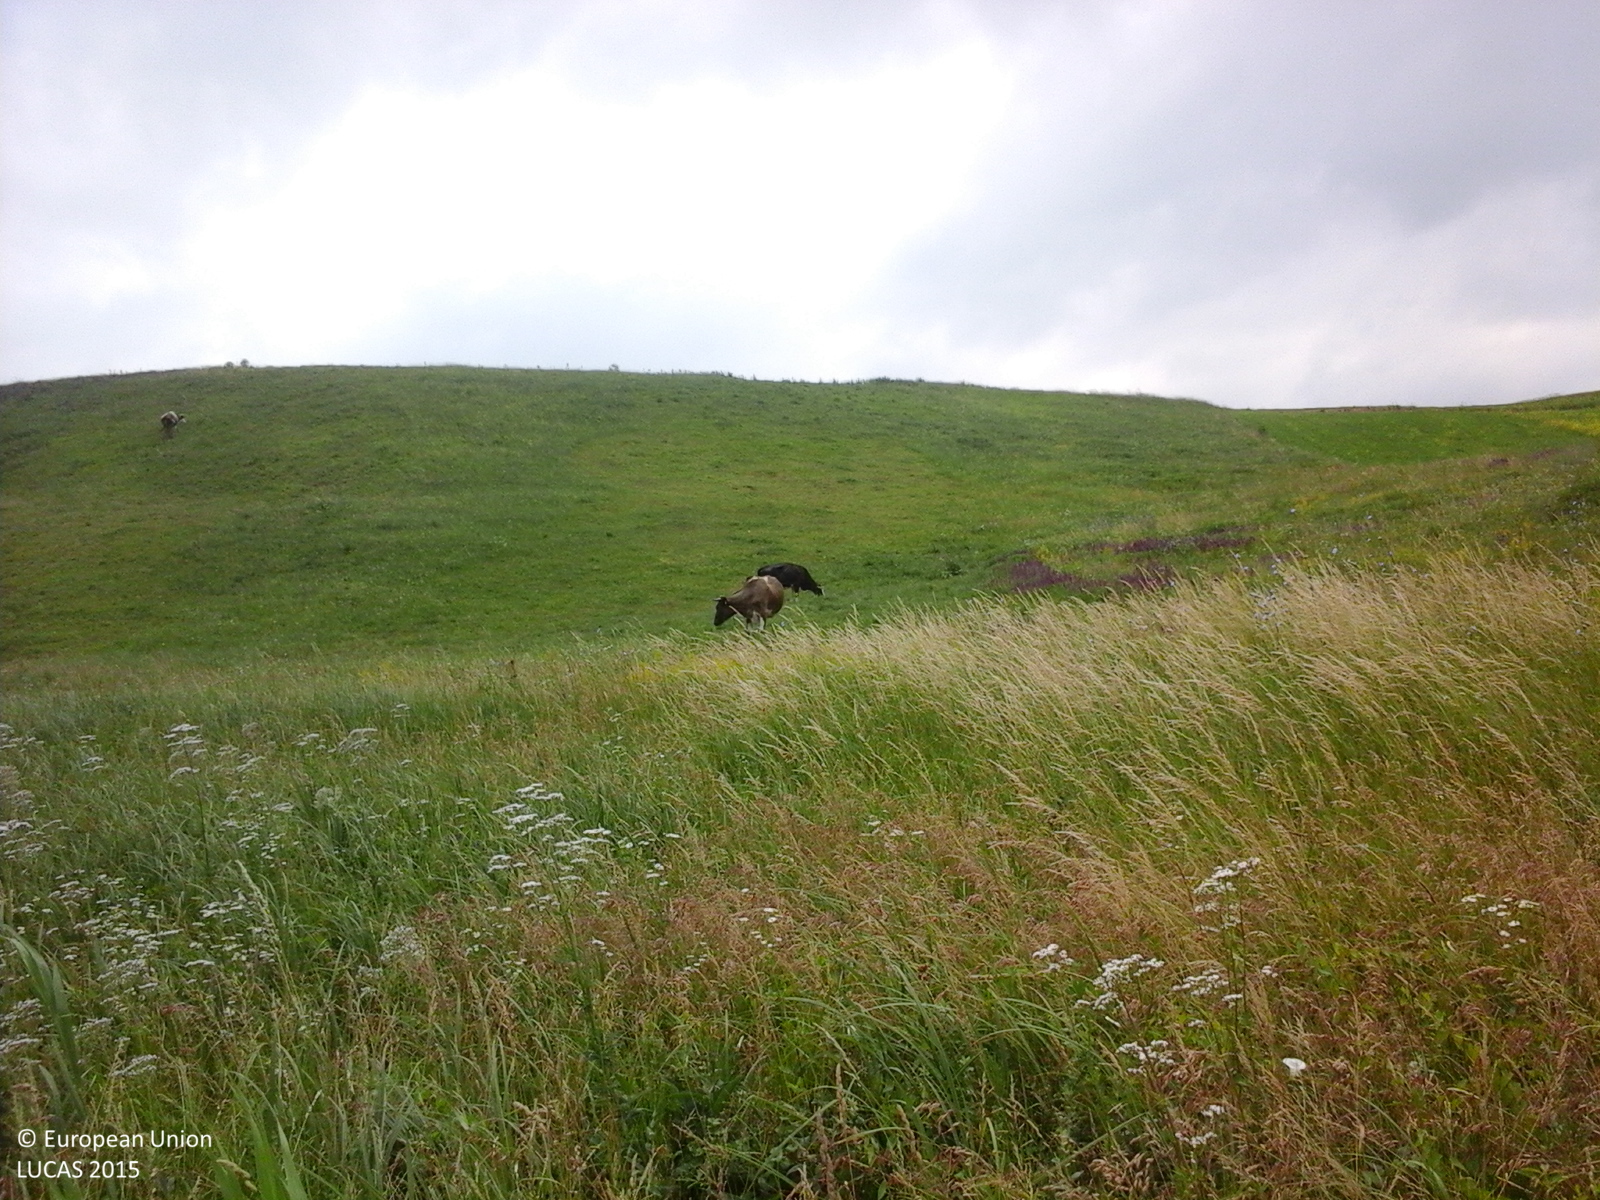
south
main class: Grassland
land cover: Grassland without tree/shrub cover
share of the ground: > 75 %
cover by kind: herbaceous plants 100 %
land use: Agriculture (excluding fallow land and kitchen gardens)
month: June
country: RO
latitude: 48.0506
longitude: 26.3893
